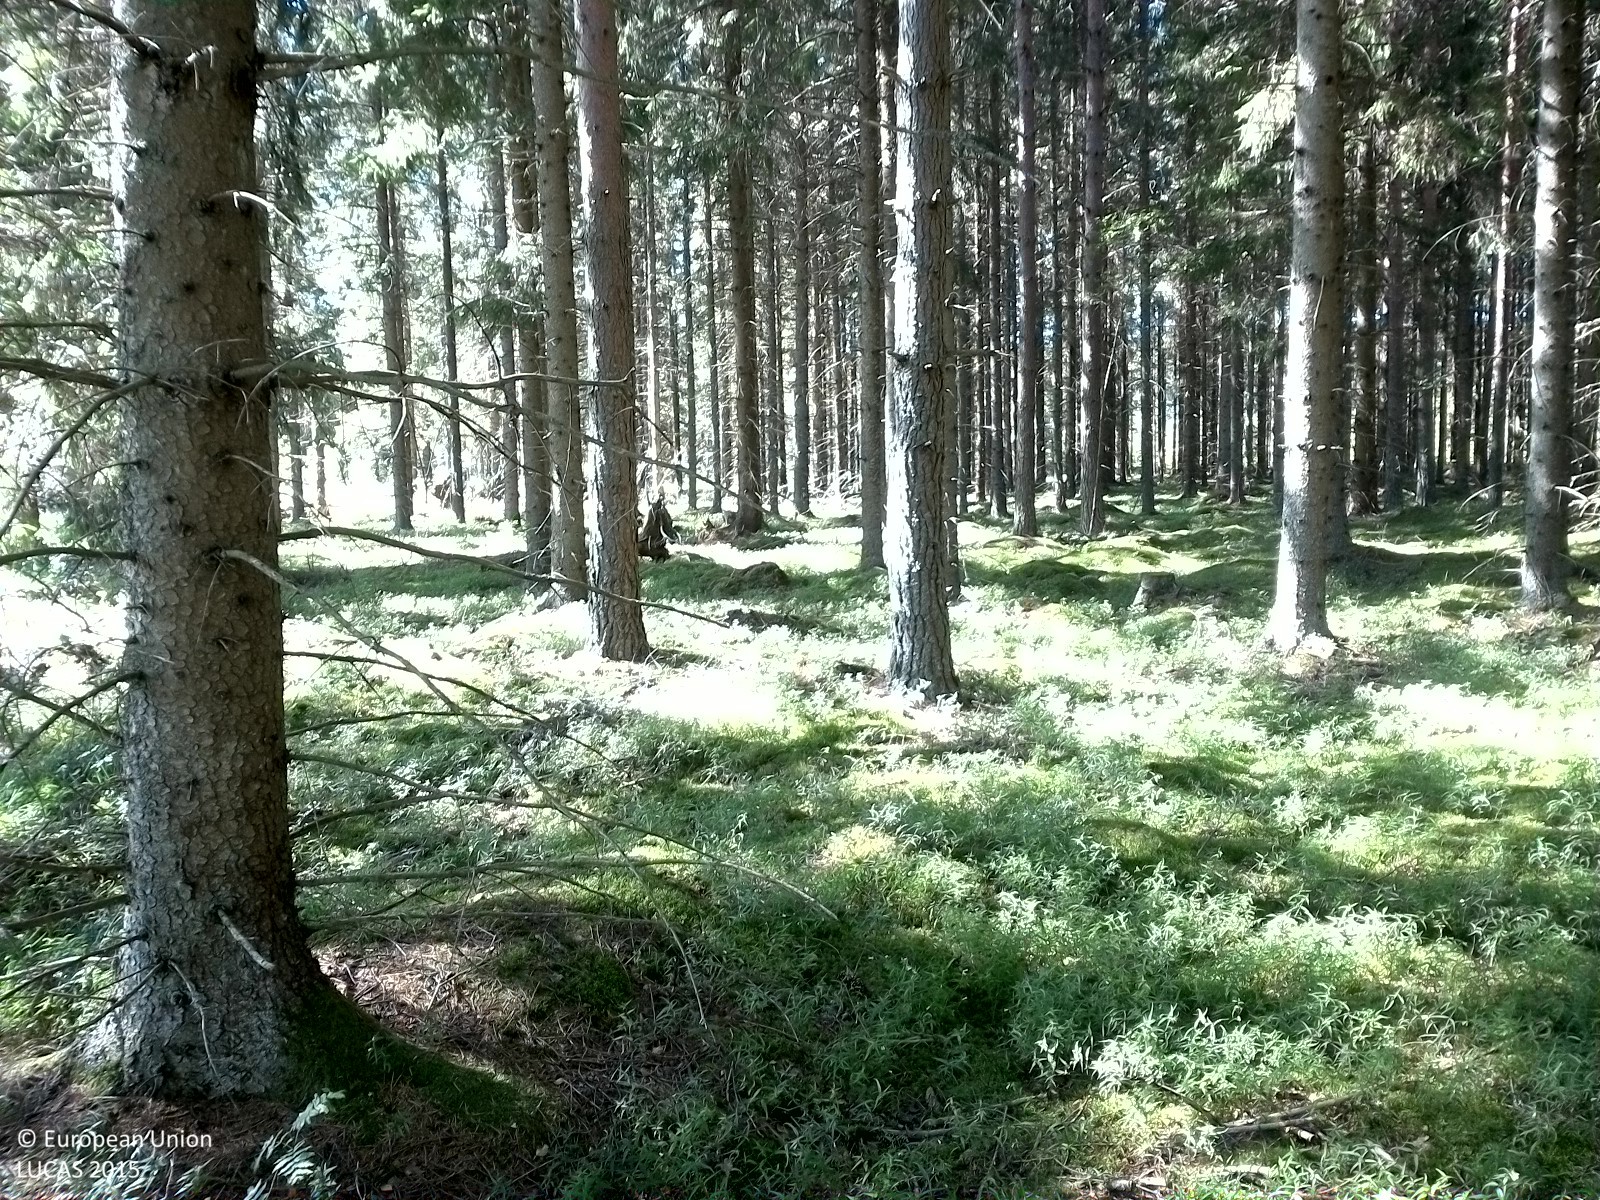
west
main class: Woodland
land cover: Spruce dominated coniferous woodland
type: boreal forest
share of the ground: 50 - 75 %
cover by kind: coniferous forest trees 55 %, lichens and mosses 25 %, herbaceous plants 20 %
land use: Forestry
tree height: > 5 m
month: August
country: SE
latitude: 59.4203
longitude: 15.1194
